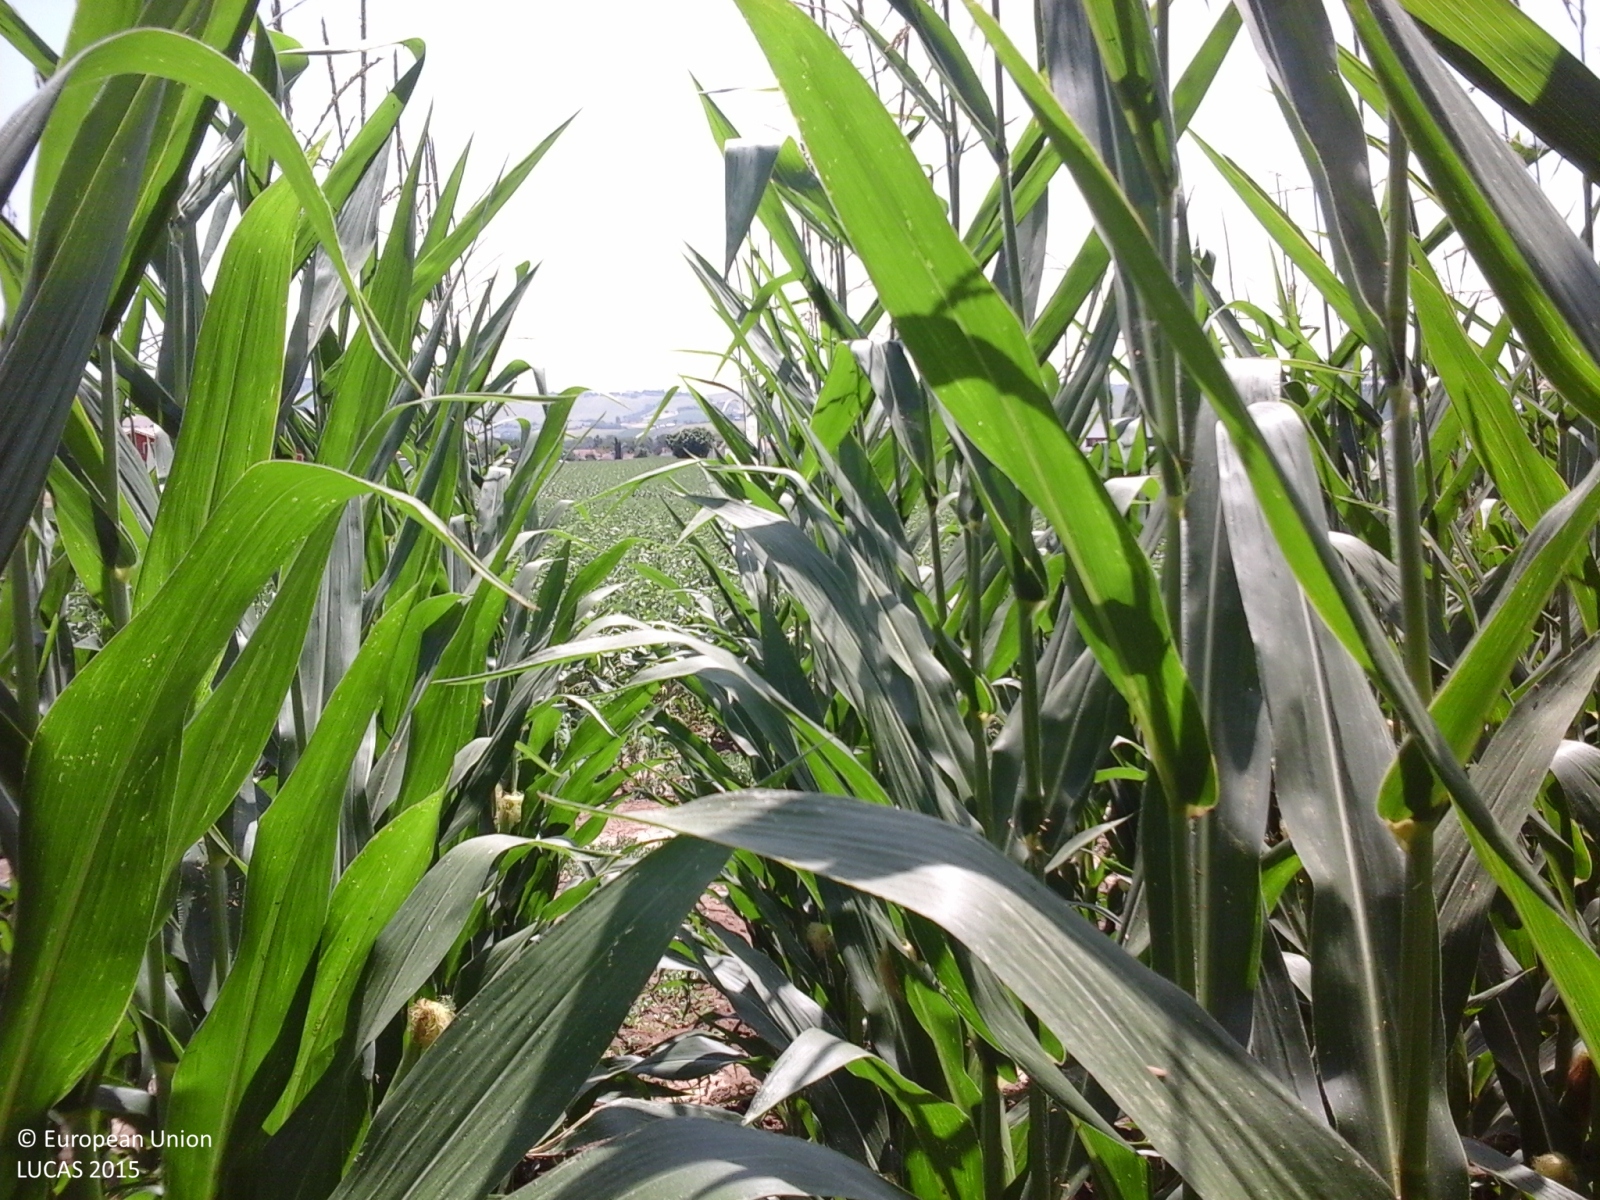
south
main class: Cropland
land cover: Maize
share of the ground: > 75 %
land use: Agriculture (excluding fallow land and kitchen gardens)
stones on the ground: < 10 %
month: July
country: IT
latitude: 43.3703
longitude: 13.5084
